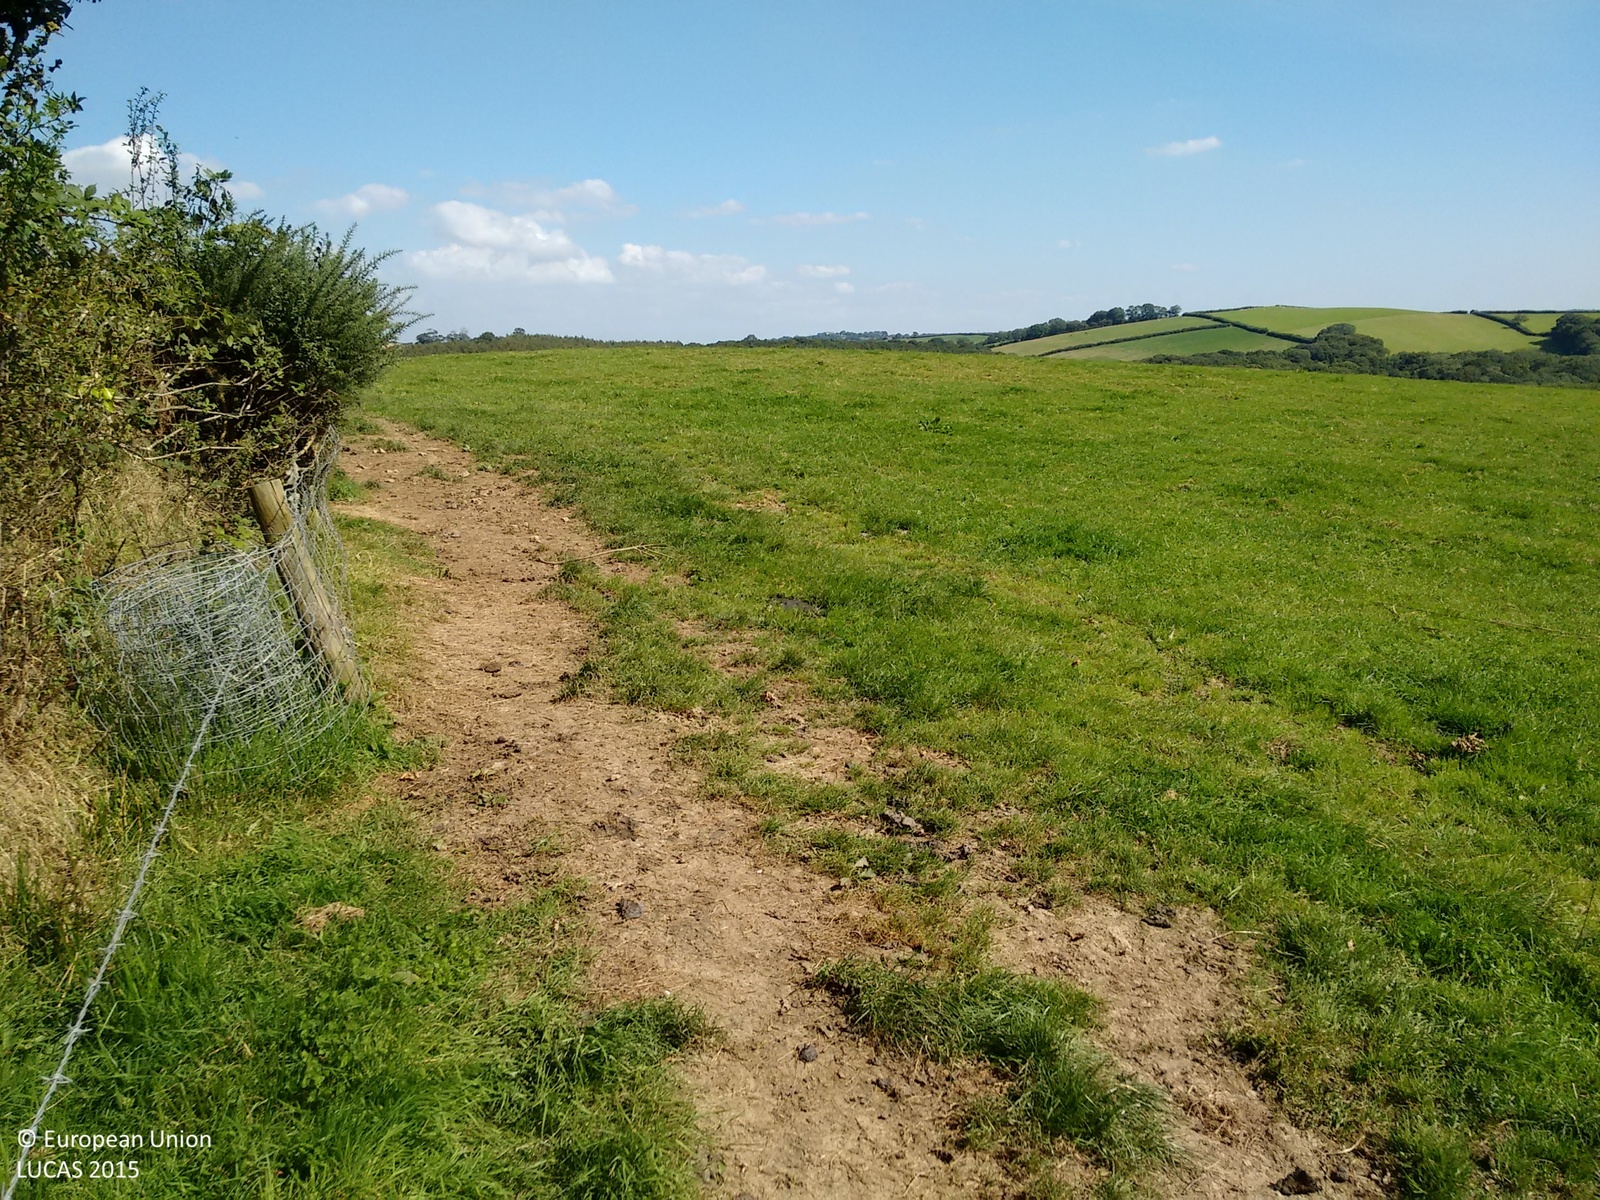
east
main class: Woodland
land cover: Broadleaved woodland
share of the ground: > 75 %
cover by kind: broadleaved forest trees 100 %
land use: Agriculture (excluding fallow land and kitchen gardens)
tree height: > 5 m
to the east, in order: Broadleaved woodland; Fences; Grassland without tree/shrub cover; Fences; Managed hedges; Artificial constructions; Grass margins; Barley
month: September
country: GB
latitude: 50.8593
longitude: -4.0605
